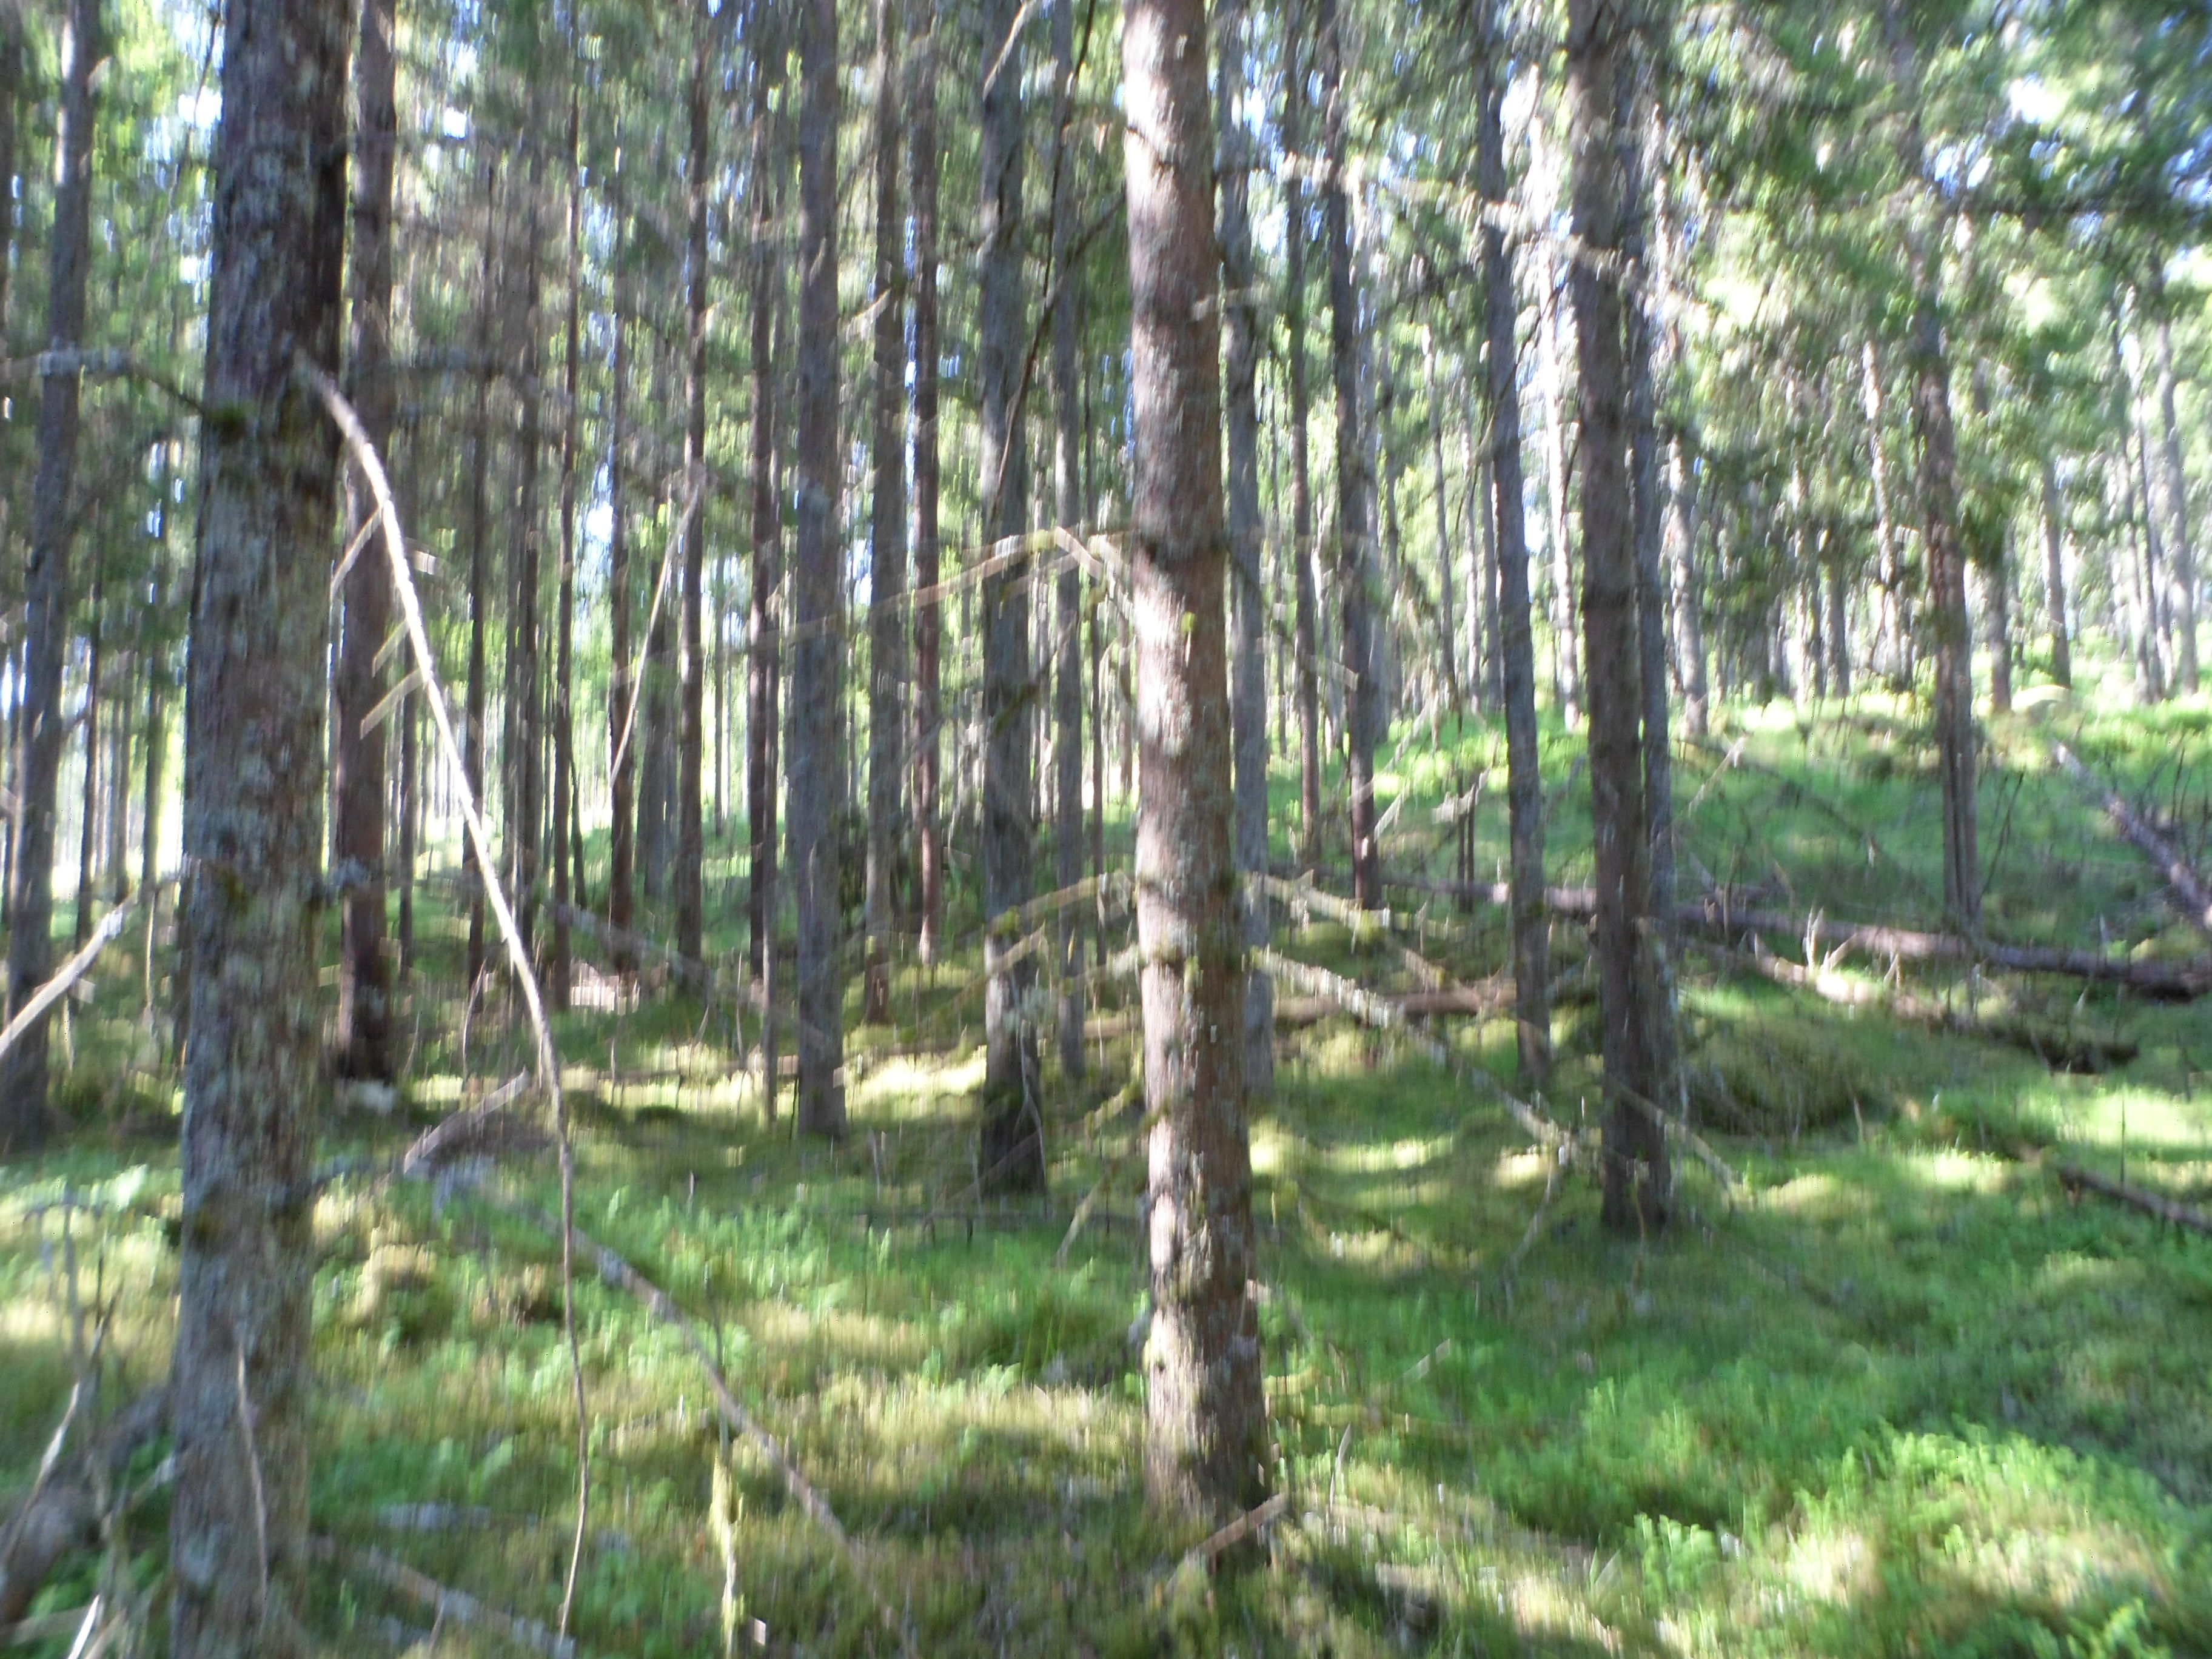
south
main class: Woodland
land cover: Spruce dominated coniferous woodland
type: boreal forest
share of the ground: 50 - 75 %
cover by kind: coniferous forest trees 70 %, lichens and mosses 15 %, shrubs 10 %, herbaceous plants 5 %
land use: Forestry
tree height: > 5 m
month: June
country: SE
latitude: 57.4603
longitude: 13.9128
